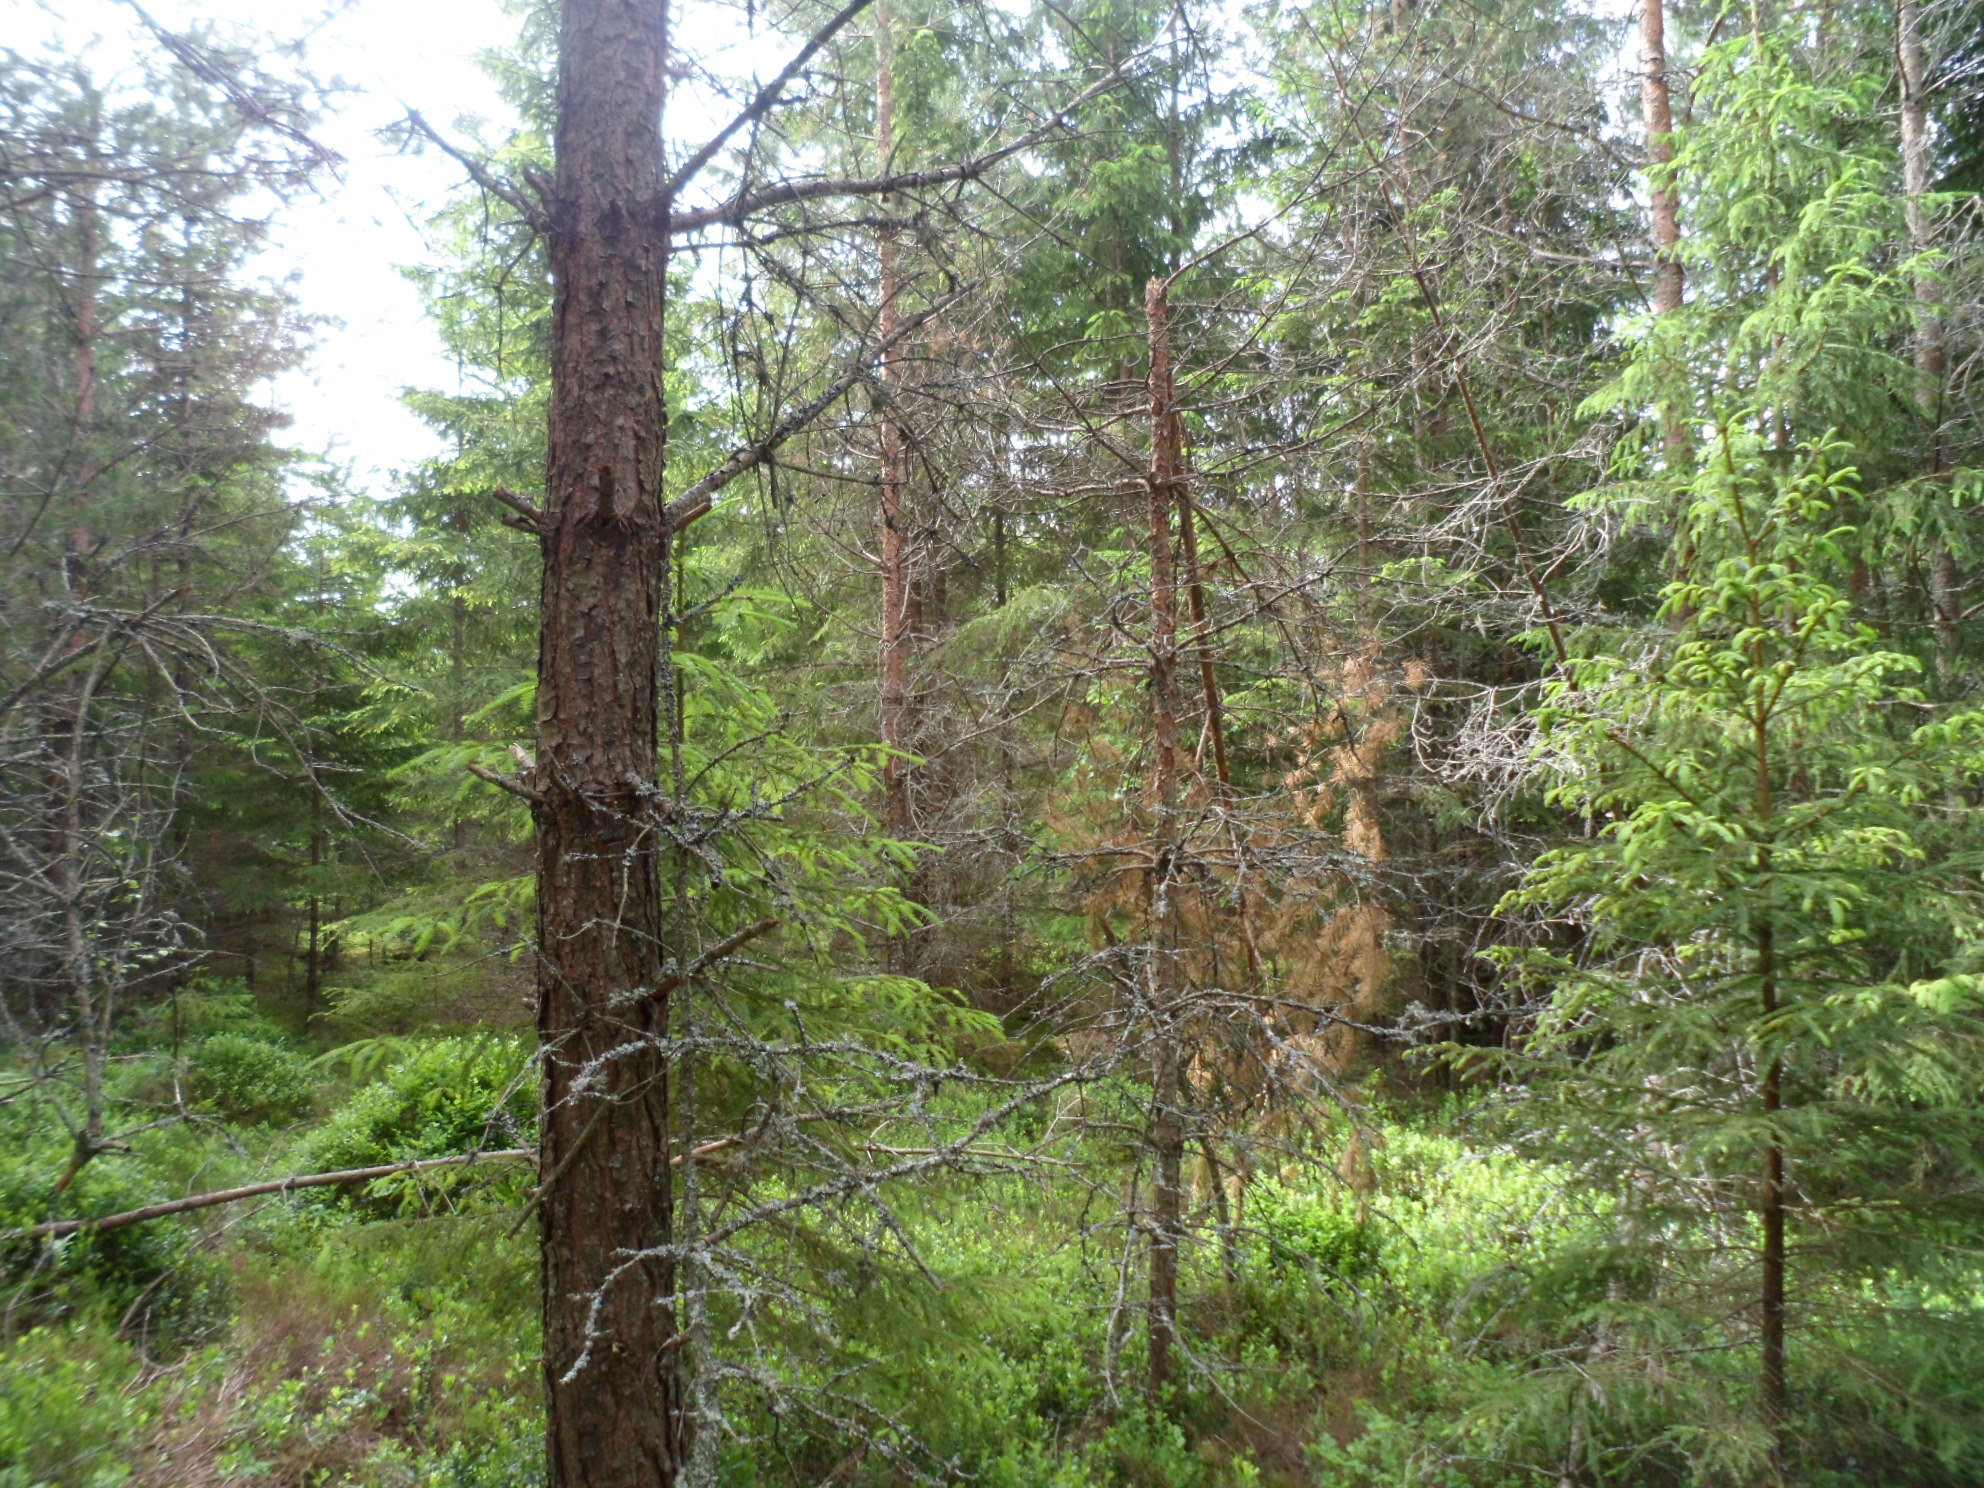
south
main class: Woodland
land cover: Pine dominated coniferous woodland
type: boreal forest
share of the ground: 50 - 75 %
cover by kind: coniferous forest trees 70 %, shrubs 15 %, lichens and mosses 10 %, herbaceous plants 5 %
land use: Forestry
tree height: > 5 m
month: June
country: SE
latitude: 57.0161
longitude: 15.2843
